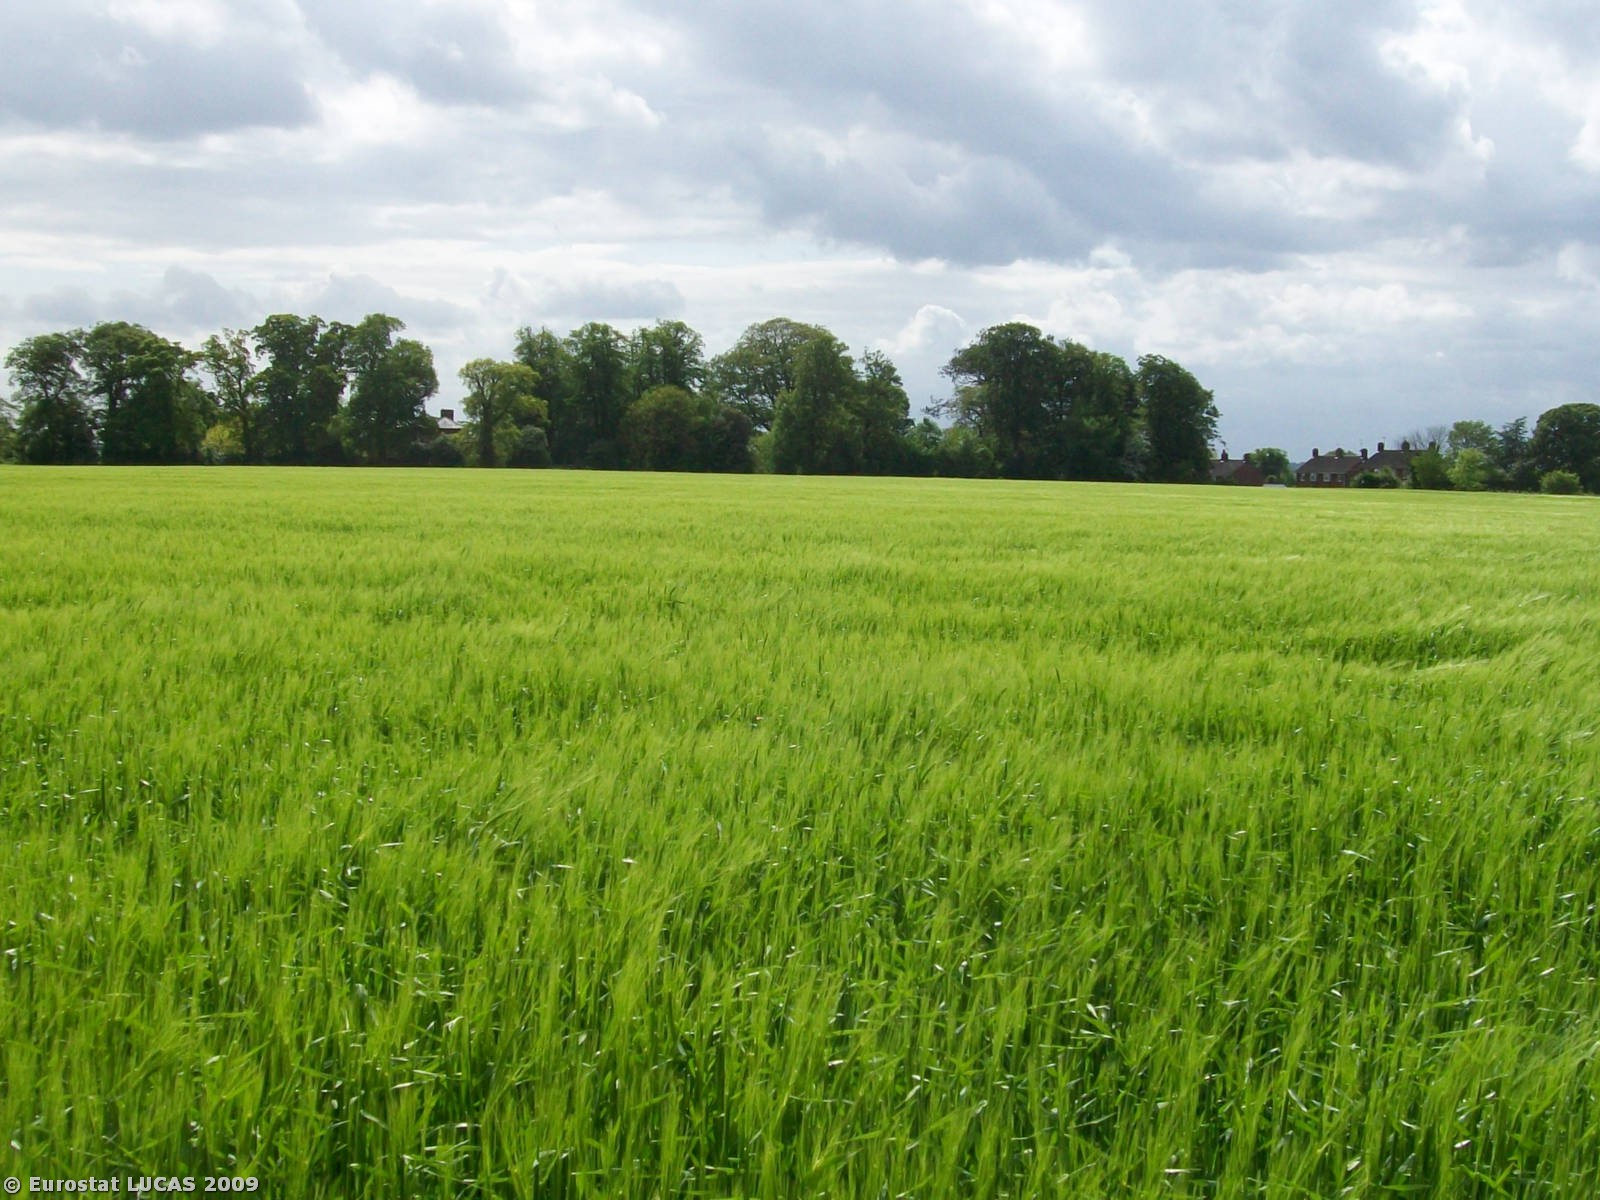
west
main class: Cropland
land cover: Barley
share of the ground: > 75 %
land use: Agriculture (excluding fallow land and kitchen gardens)
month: May
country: GB
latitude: 52.6400
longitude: 1.6028
